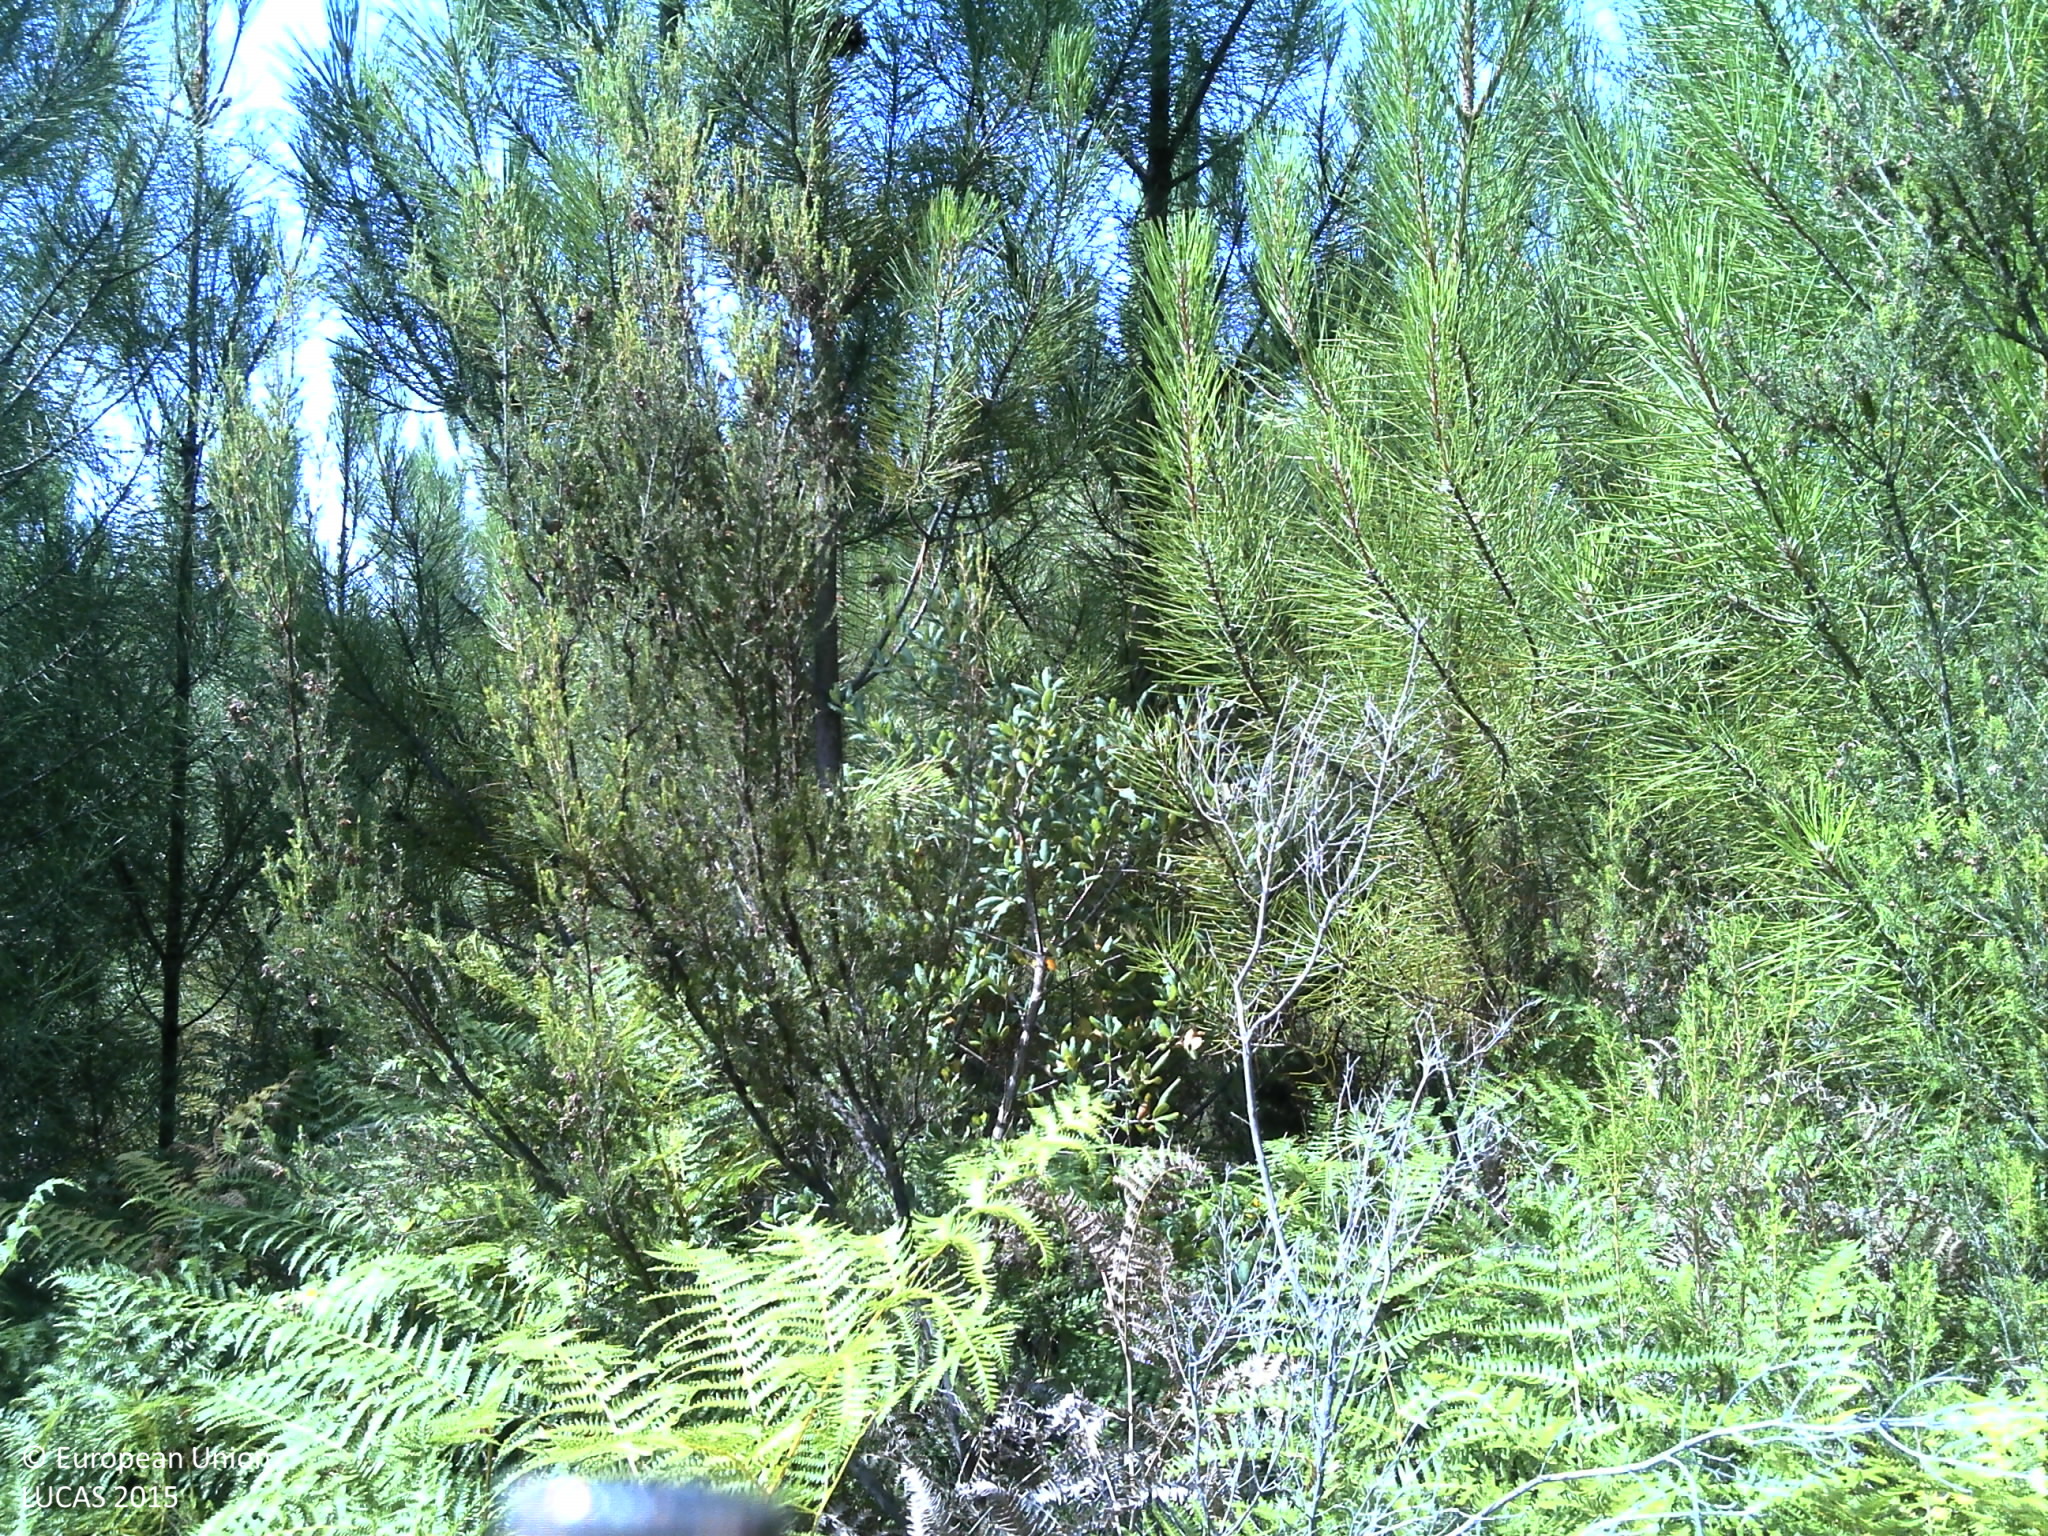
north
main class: Woodland
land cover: Pine dominated coniferous woodland
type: coniferous forest of the mediterranean region
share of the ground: 25 - 50 %
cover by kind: shrubs 65 %, coniferous forest trees 30 %, herbaceous plants 5 %
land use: Forestry
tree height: > 5 m
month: July
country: PT
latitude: 39.9130
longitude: -8.0244
